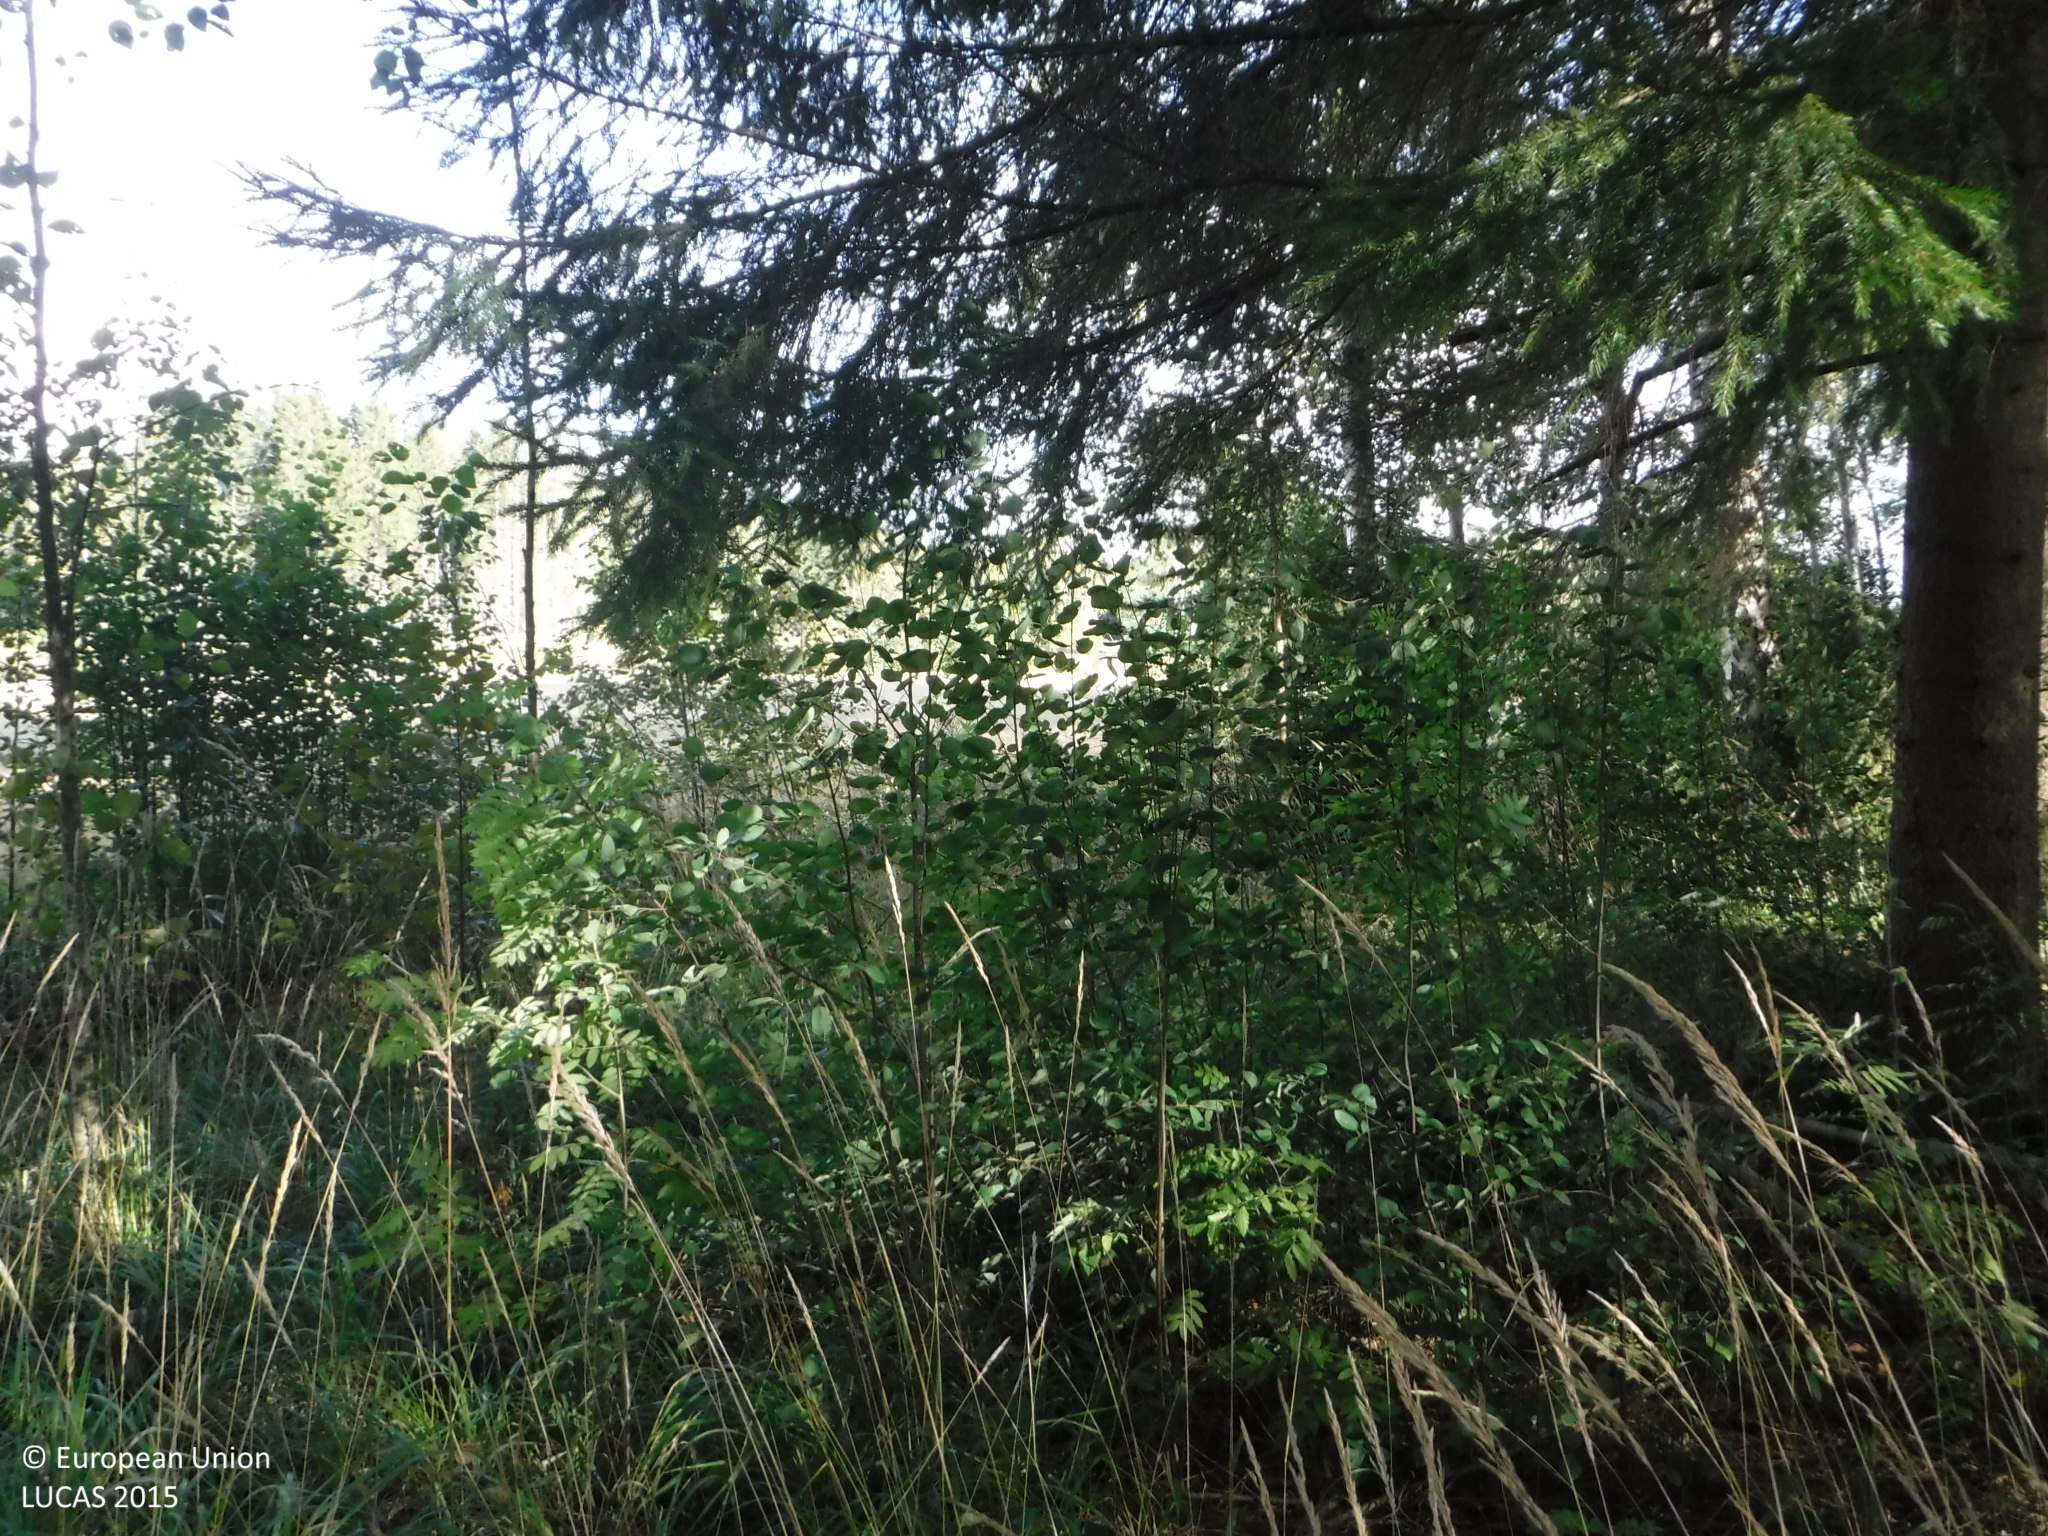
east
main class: Woodland
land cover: Spruce dominated coniferous woodland
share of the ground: > 75 %
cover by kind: coniferous forest trees 75 %, herbaceous plants 15 %, broadleaved forest trees 5 %, lichens and mosses 5 %
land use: Forestry
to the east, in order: Spruce dominated coniferous woodland; Groves; Ditches and canals; Grass margins; Oats; Grass margins; Ditches and canals; Grass margins; Paved roads, cycling and walking lanes; Grass margins; Ditches and canals; Shruby margins; Broadleaved woodland; Spruce dominated coniferous woodland; Broadleaved woodland; Ditches and canals; Spontaneously vegetated surfaces; Oats
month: September
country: FI
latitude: 61.3977
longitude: 22.6688
